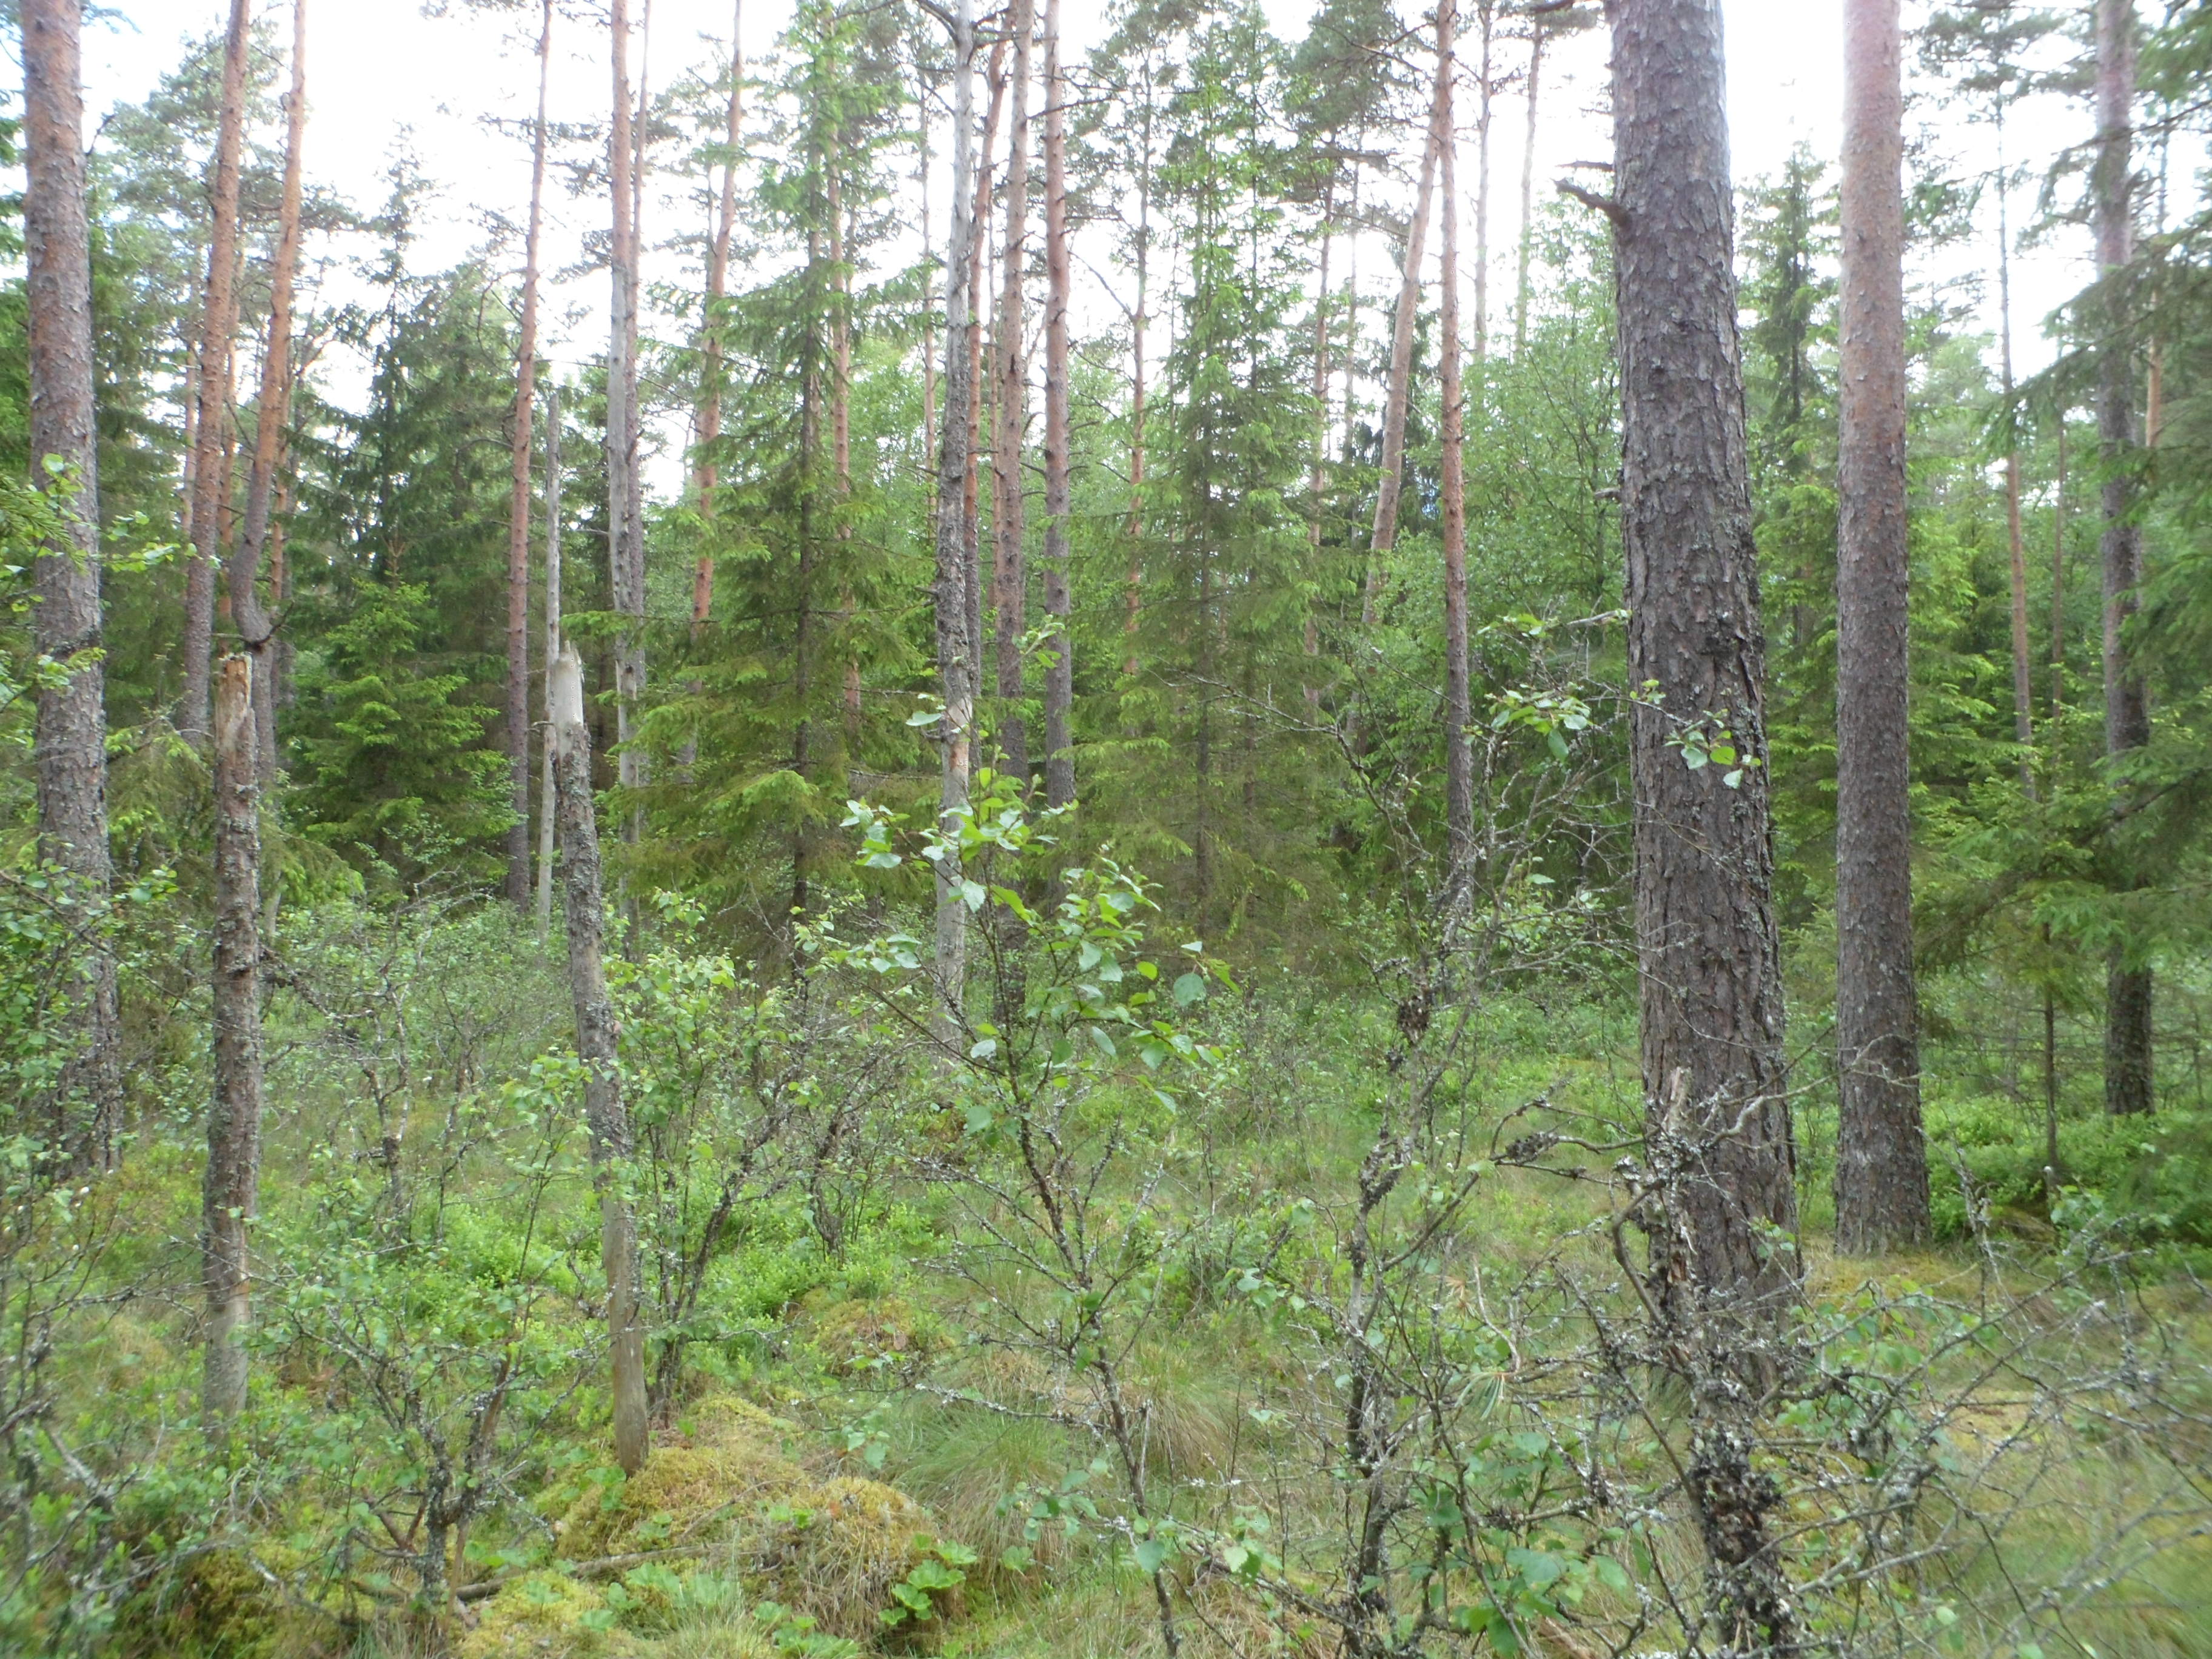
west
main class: Woodland
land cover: Pine dominated mixed woodland
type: boreal forest
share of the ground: 50 - 75 %
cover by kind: coniferous forest trees 40 %, shrubs 20 %, lichens and mosses 20 %, broadleaved forest trees 15 %, herbaceous plants 5 %
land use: Forestry
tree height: > 5 m
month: June
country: SE
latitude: 56.9086
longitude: 14.2829
